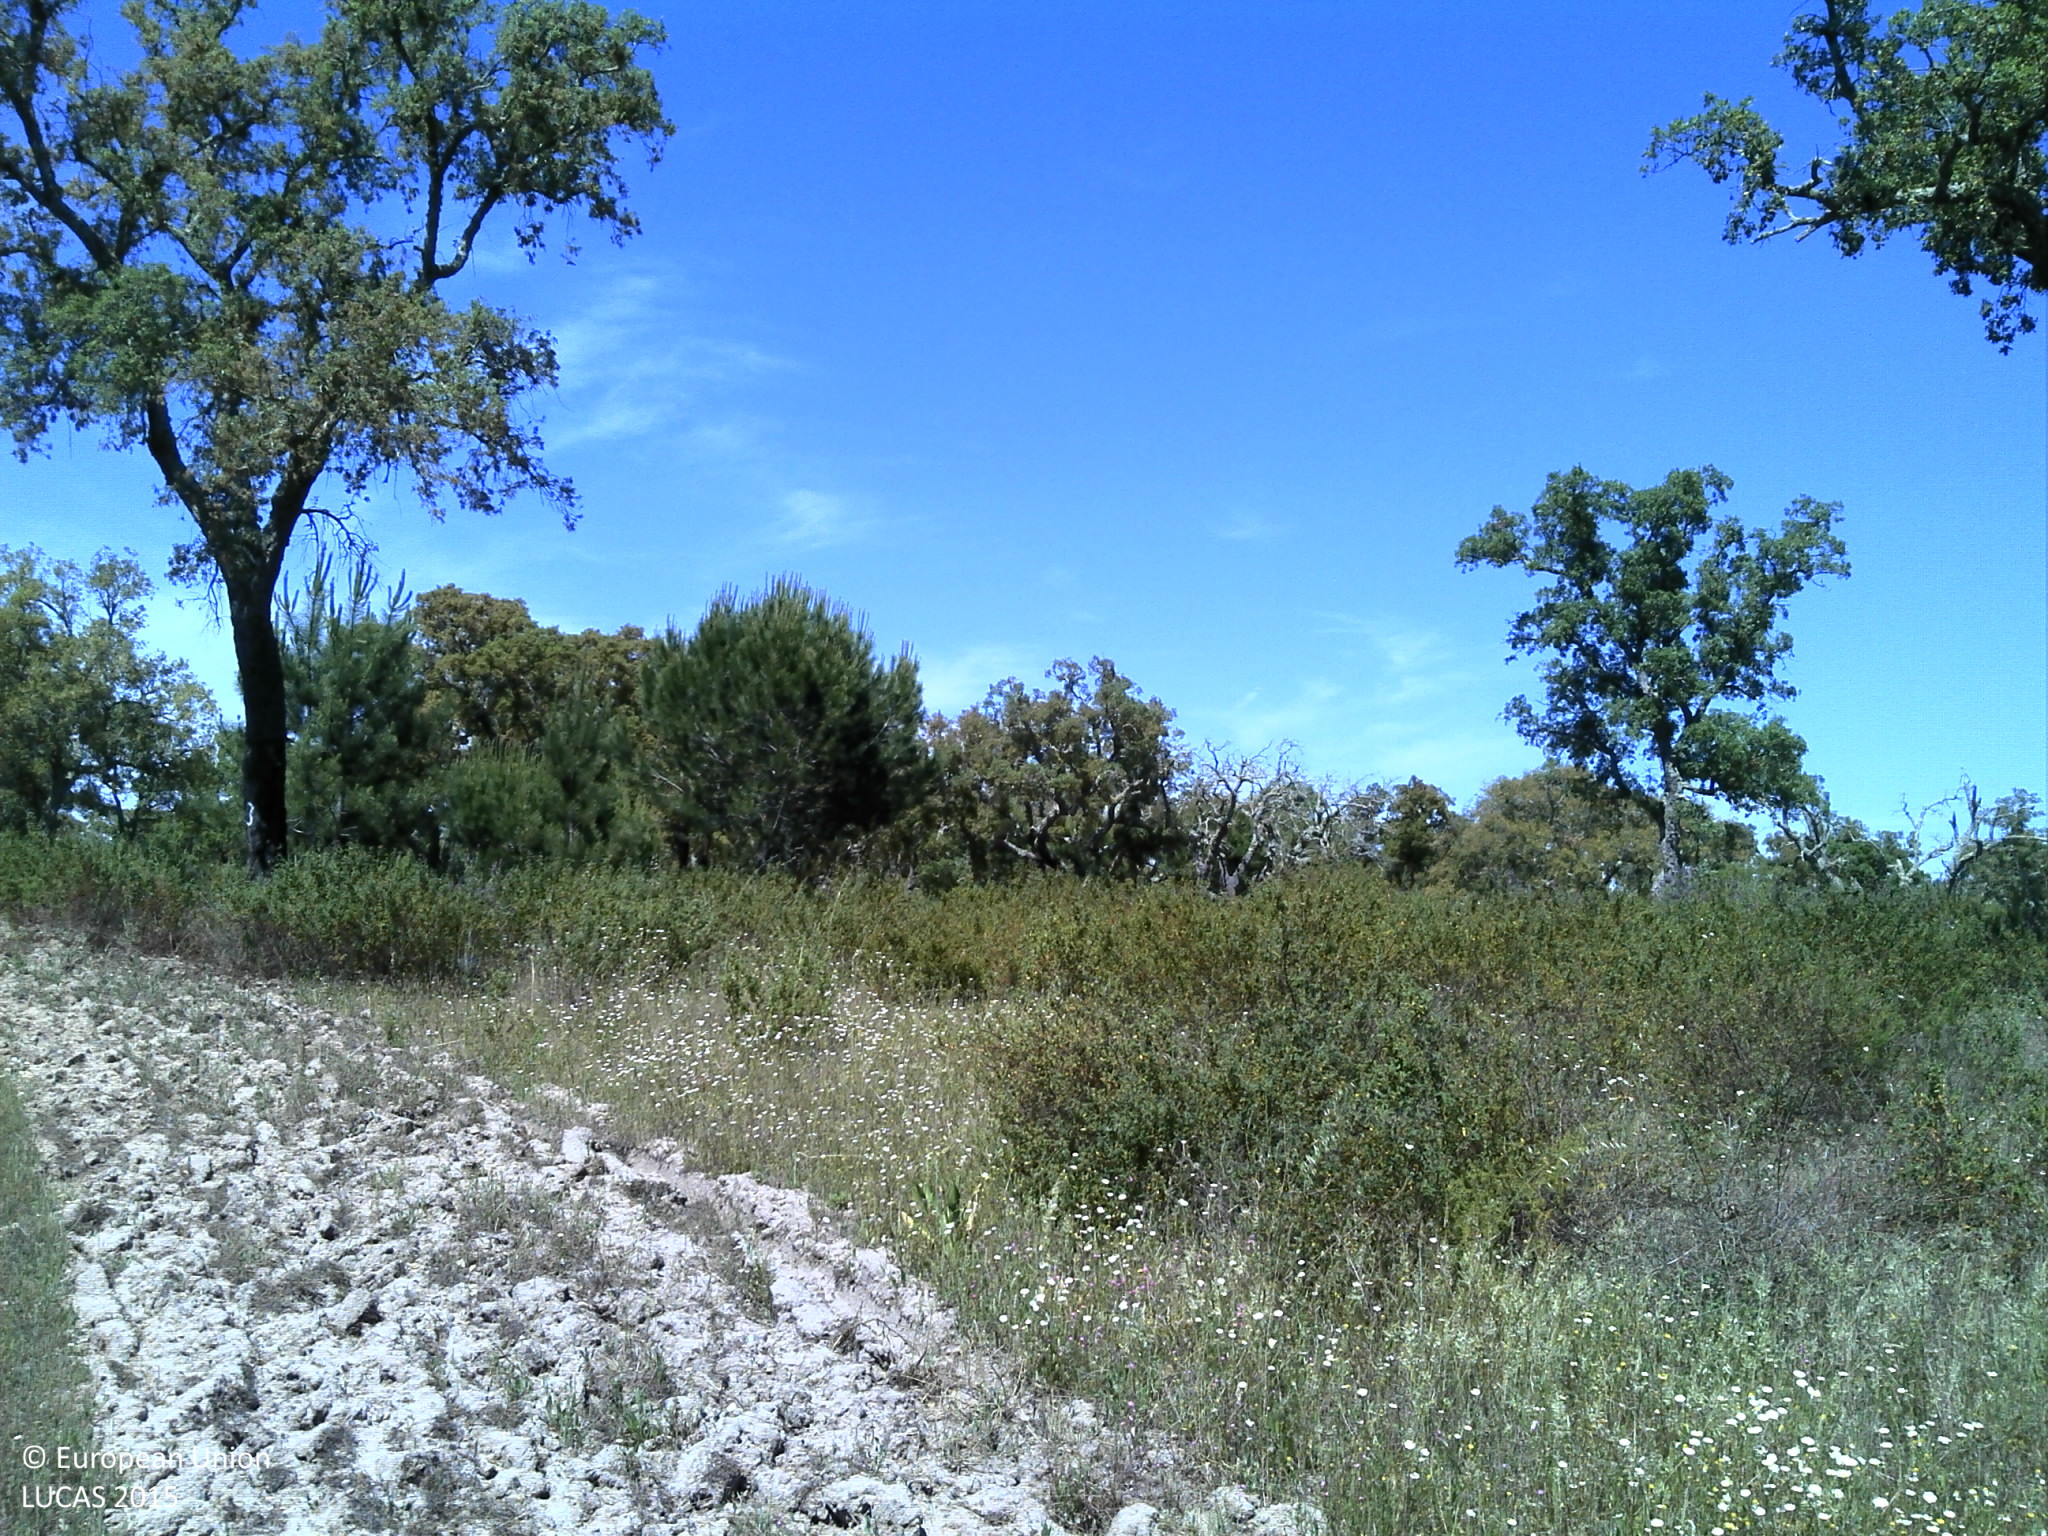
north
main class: Woodland
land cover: Broadleaved woodland
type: broadleaved evergreen forest
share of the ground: 10 - 25 %
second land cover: Grassland without tree/shrub cover
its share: 10 - 25 %
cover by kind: unconsolidated bare surface 55 %, broadleaved forest trees 15 %, shrubs 15 %, herbaceous plants 15 %
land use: Forestry
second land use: Agriculture (excluding fallow land and kitchen gardens)
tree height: > 5 m
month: May
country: PT
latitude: 39.0025
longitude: -8.1480
